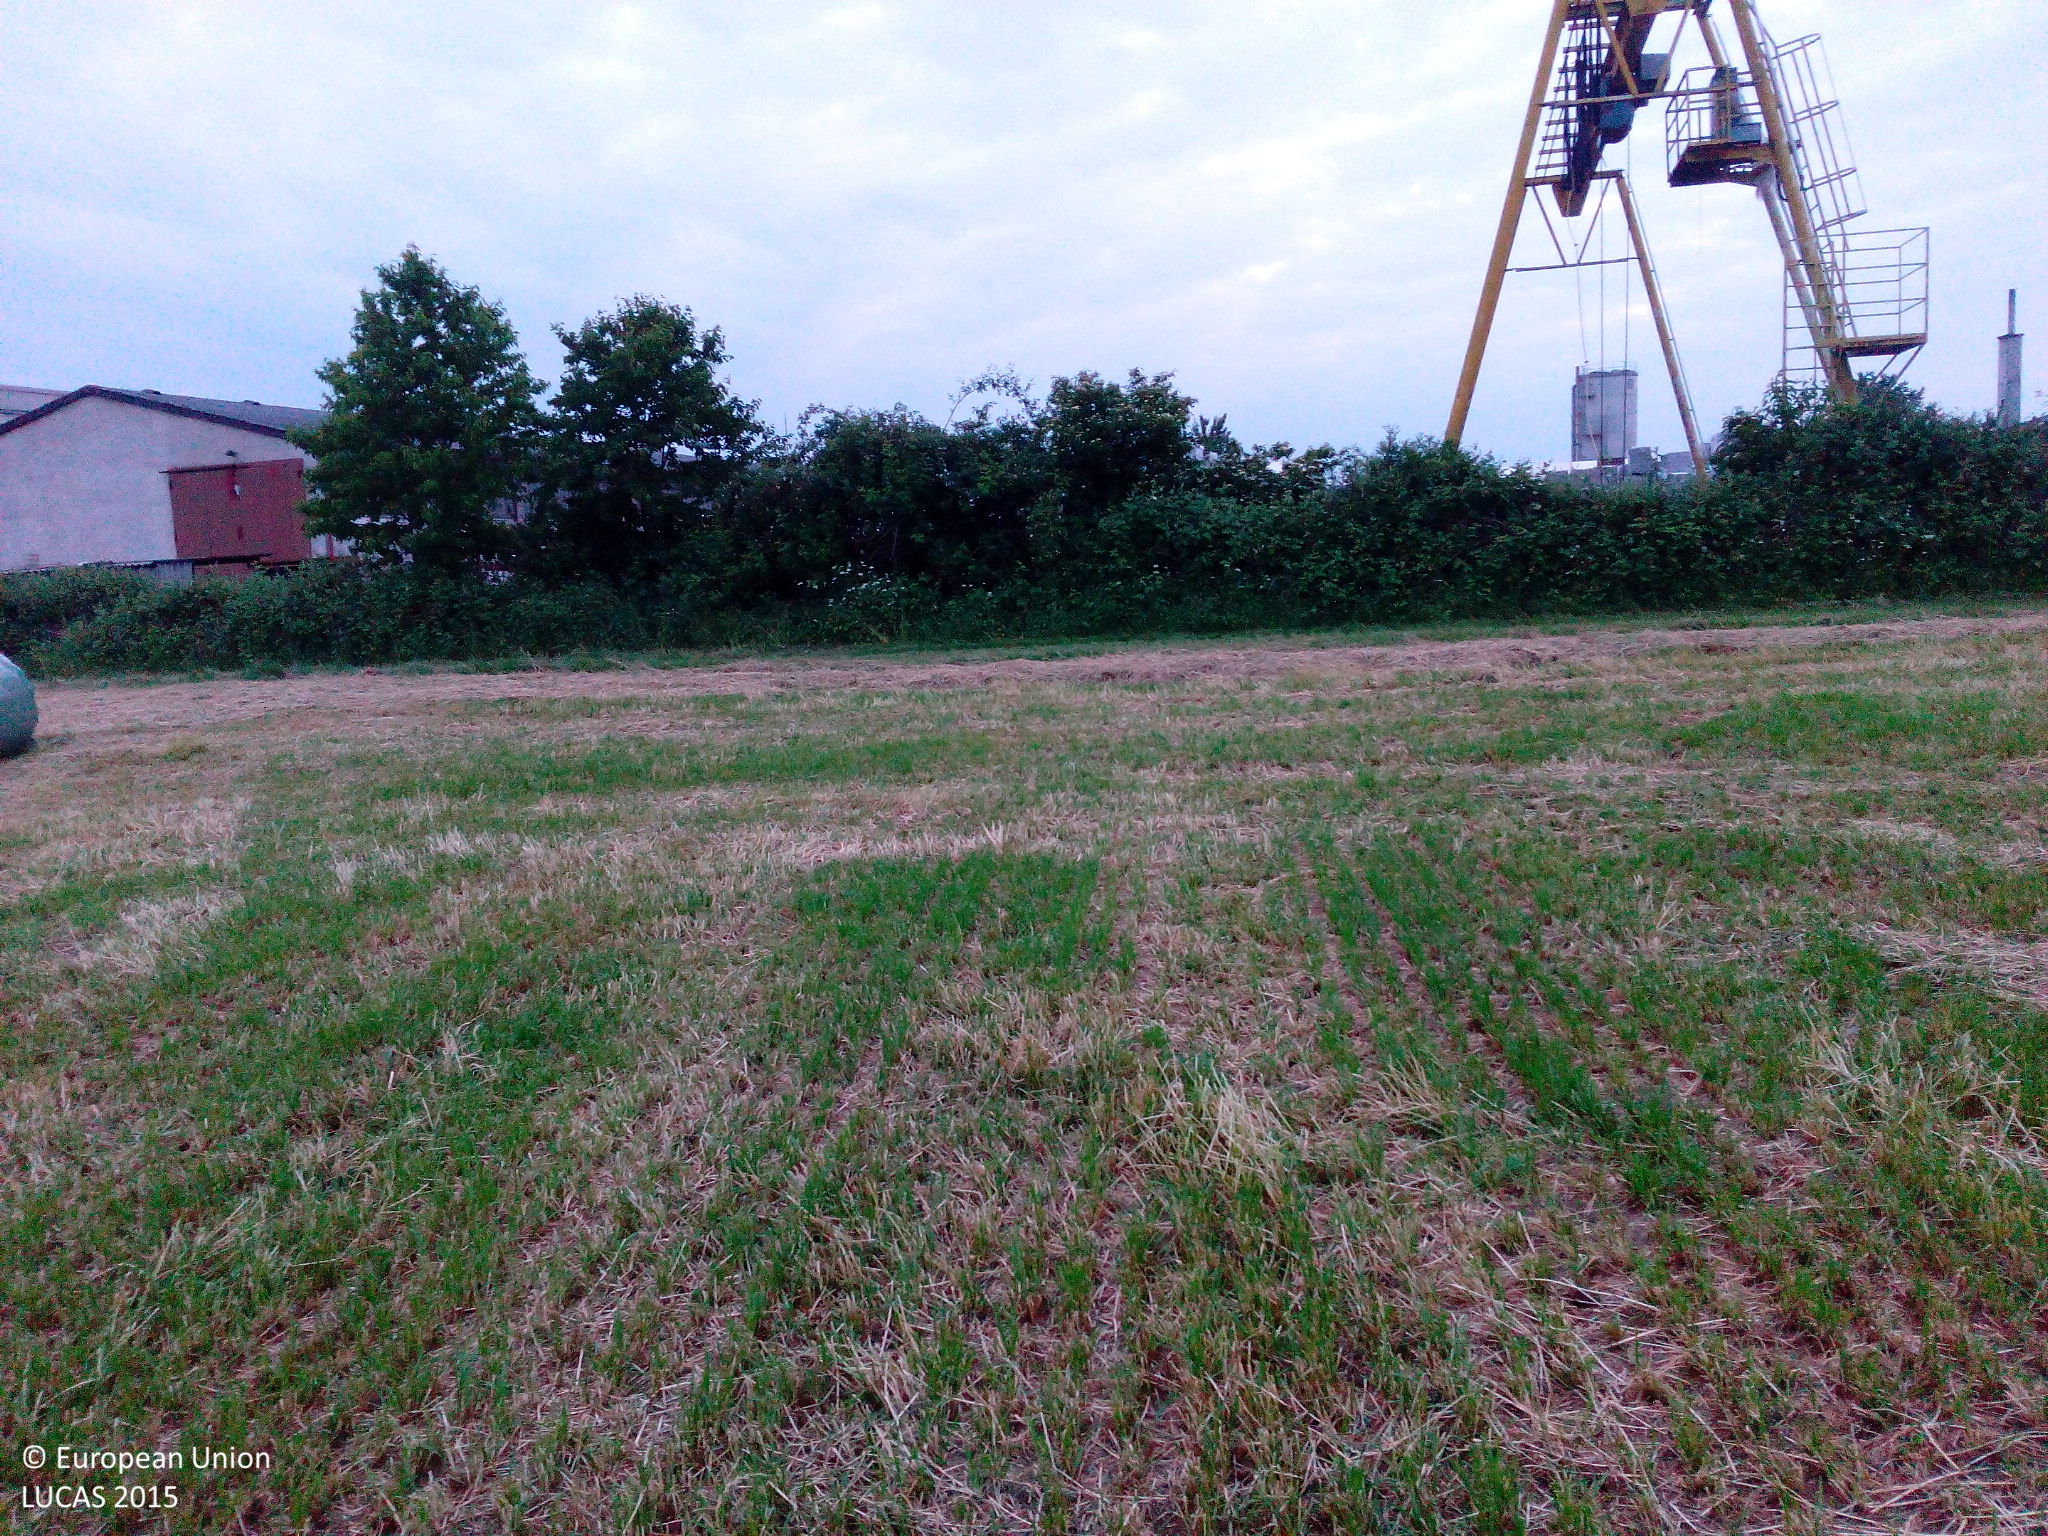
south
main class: Cropland
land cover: Temporary grasslands
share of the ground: 10 - 25 %
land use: Agriculture (excluding fallow land and kitchen gardens)
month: May
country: DE
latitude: 48.8201
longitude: 8.1620
